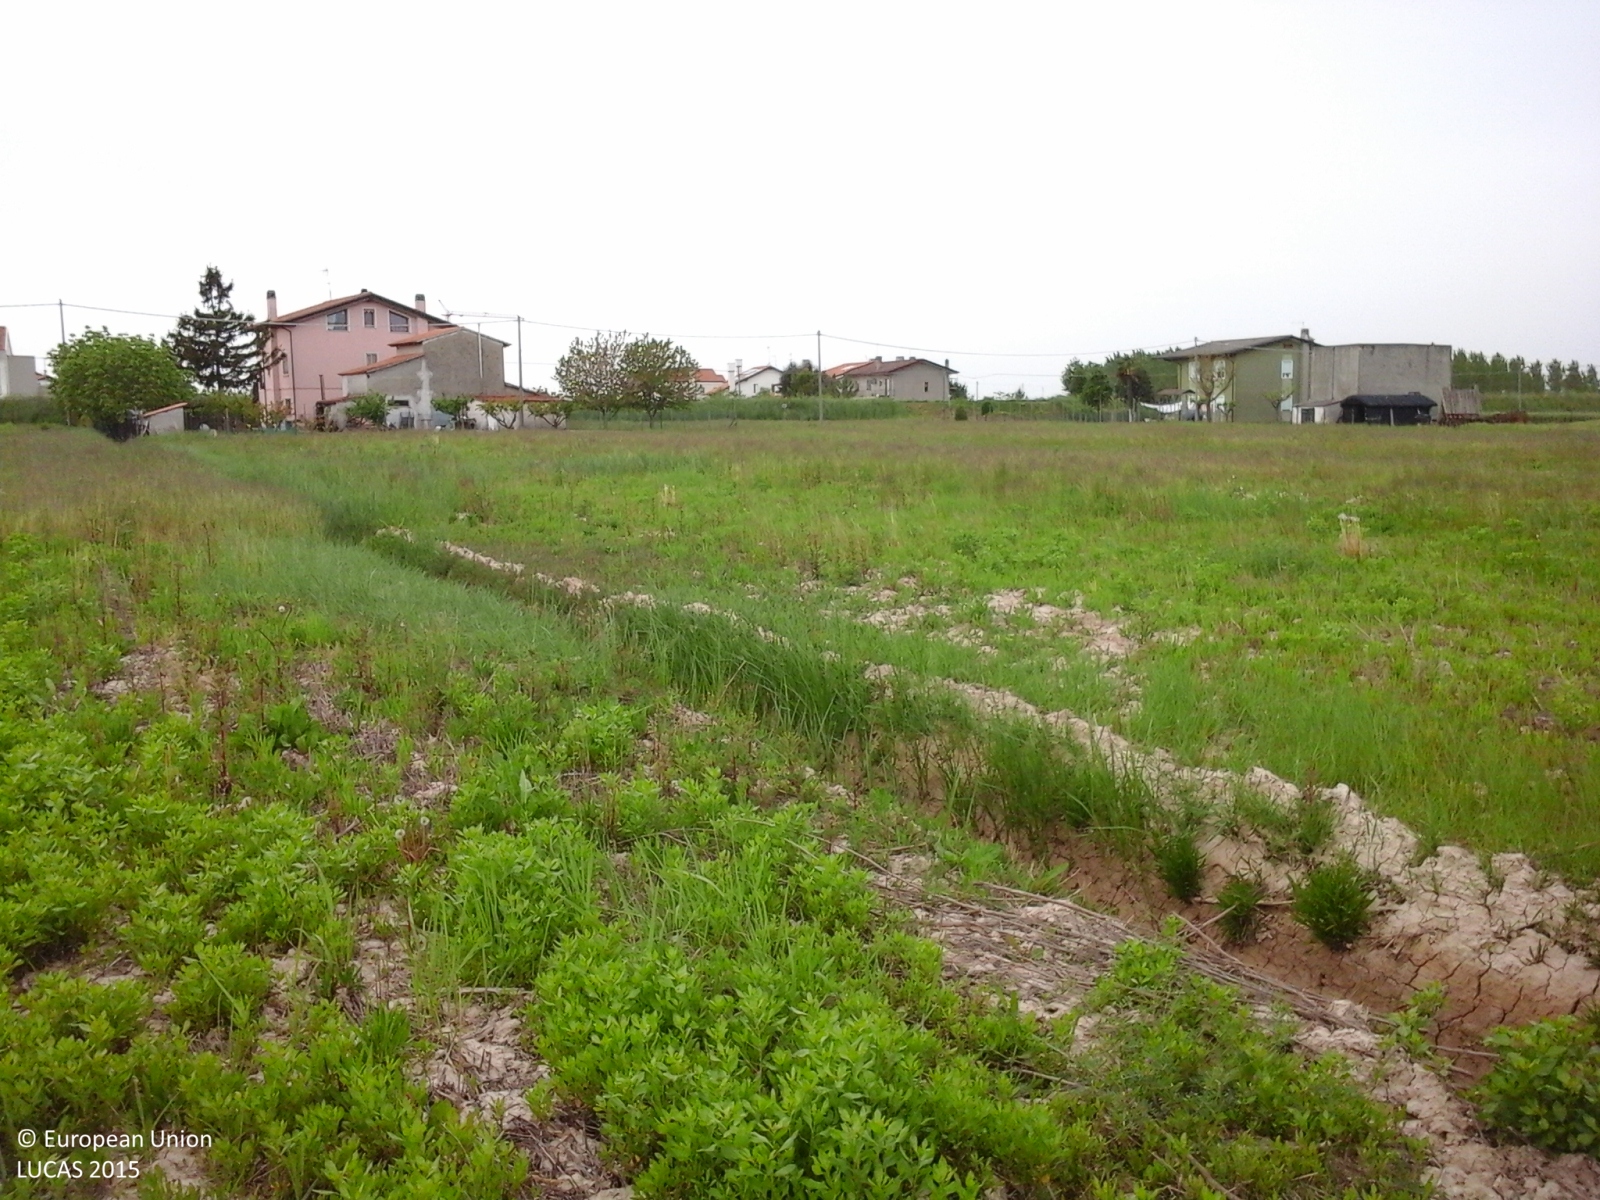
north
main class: Grassland
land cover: Spontaneously vegetated surfaces
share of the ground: > 75 %
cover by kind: herbaceous plants 80 %, consolidated bare surface 20 %
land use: Fallow land
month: May
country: IT
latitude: 45.5414
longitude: 12.7239
